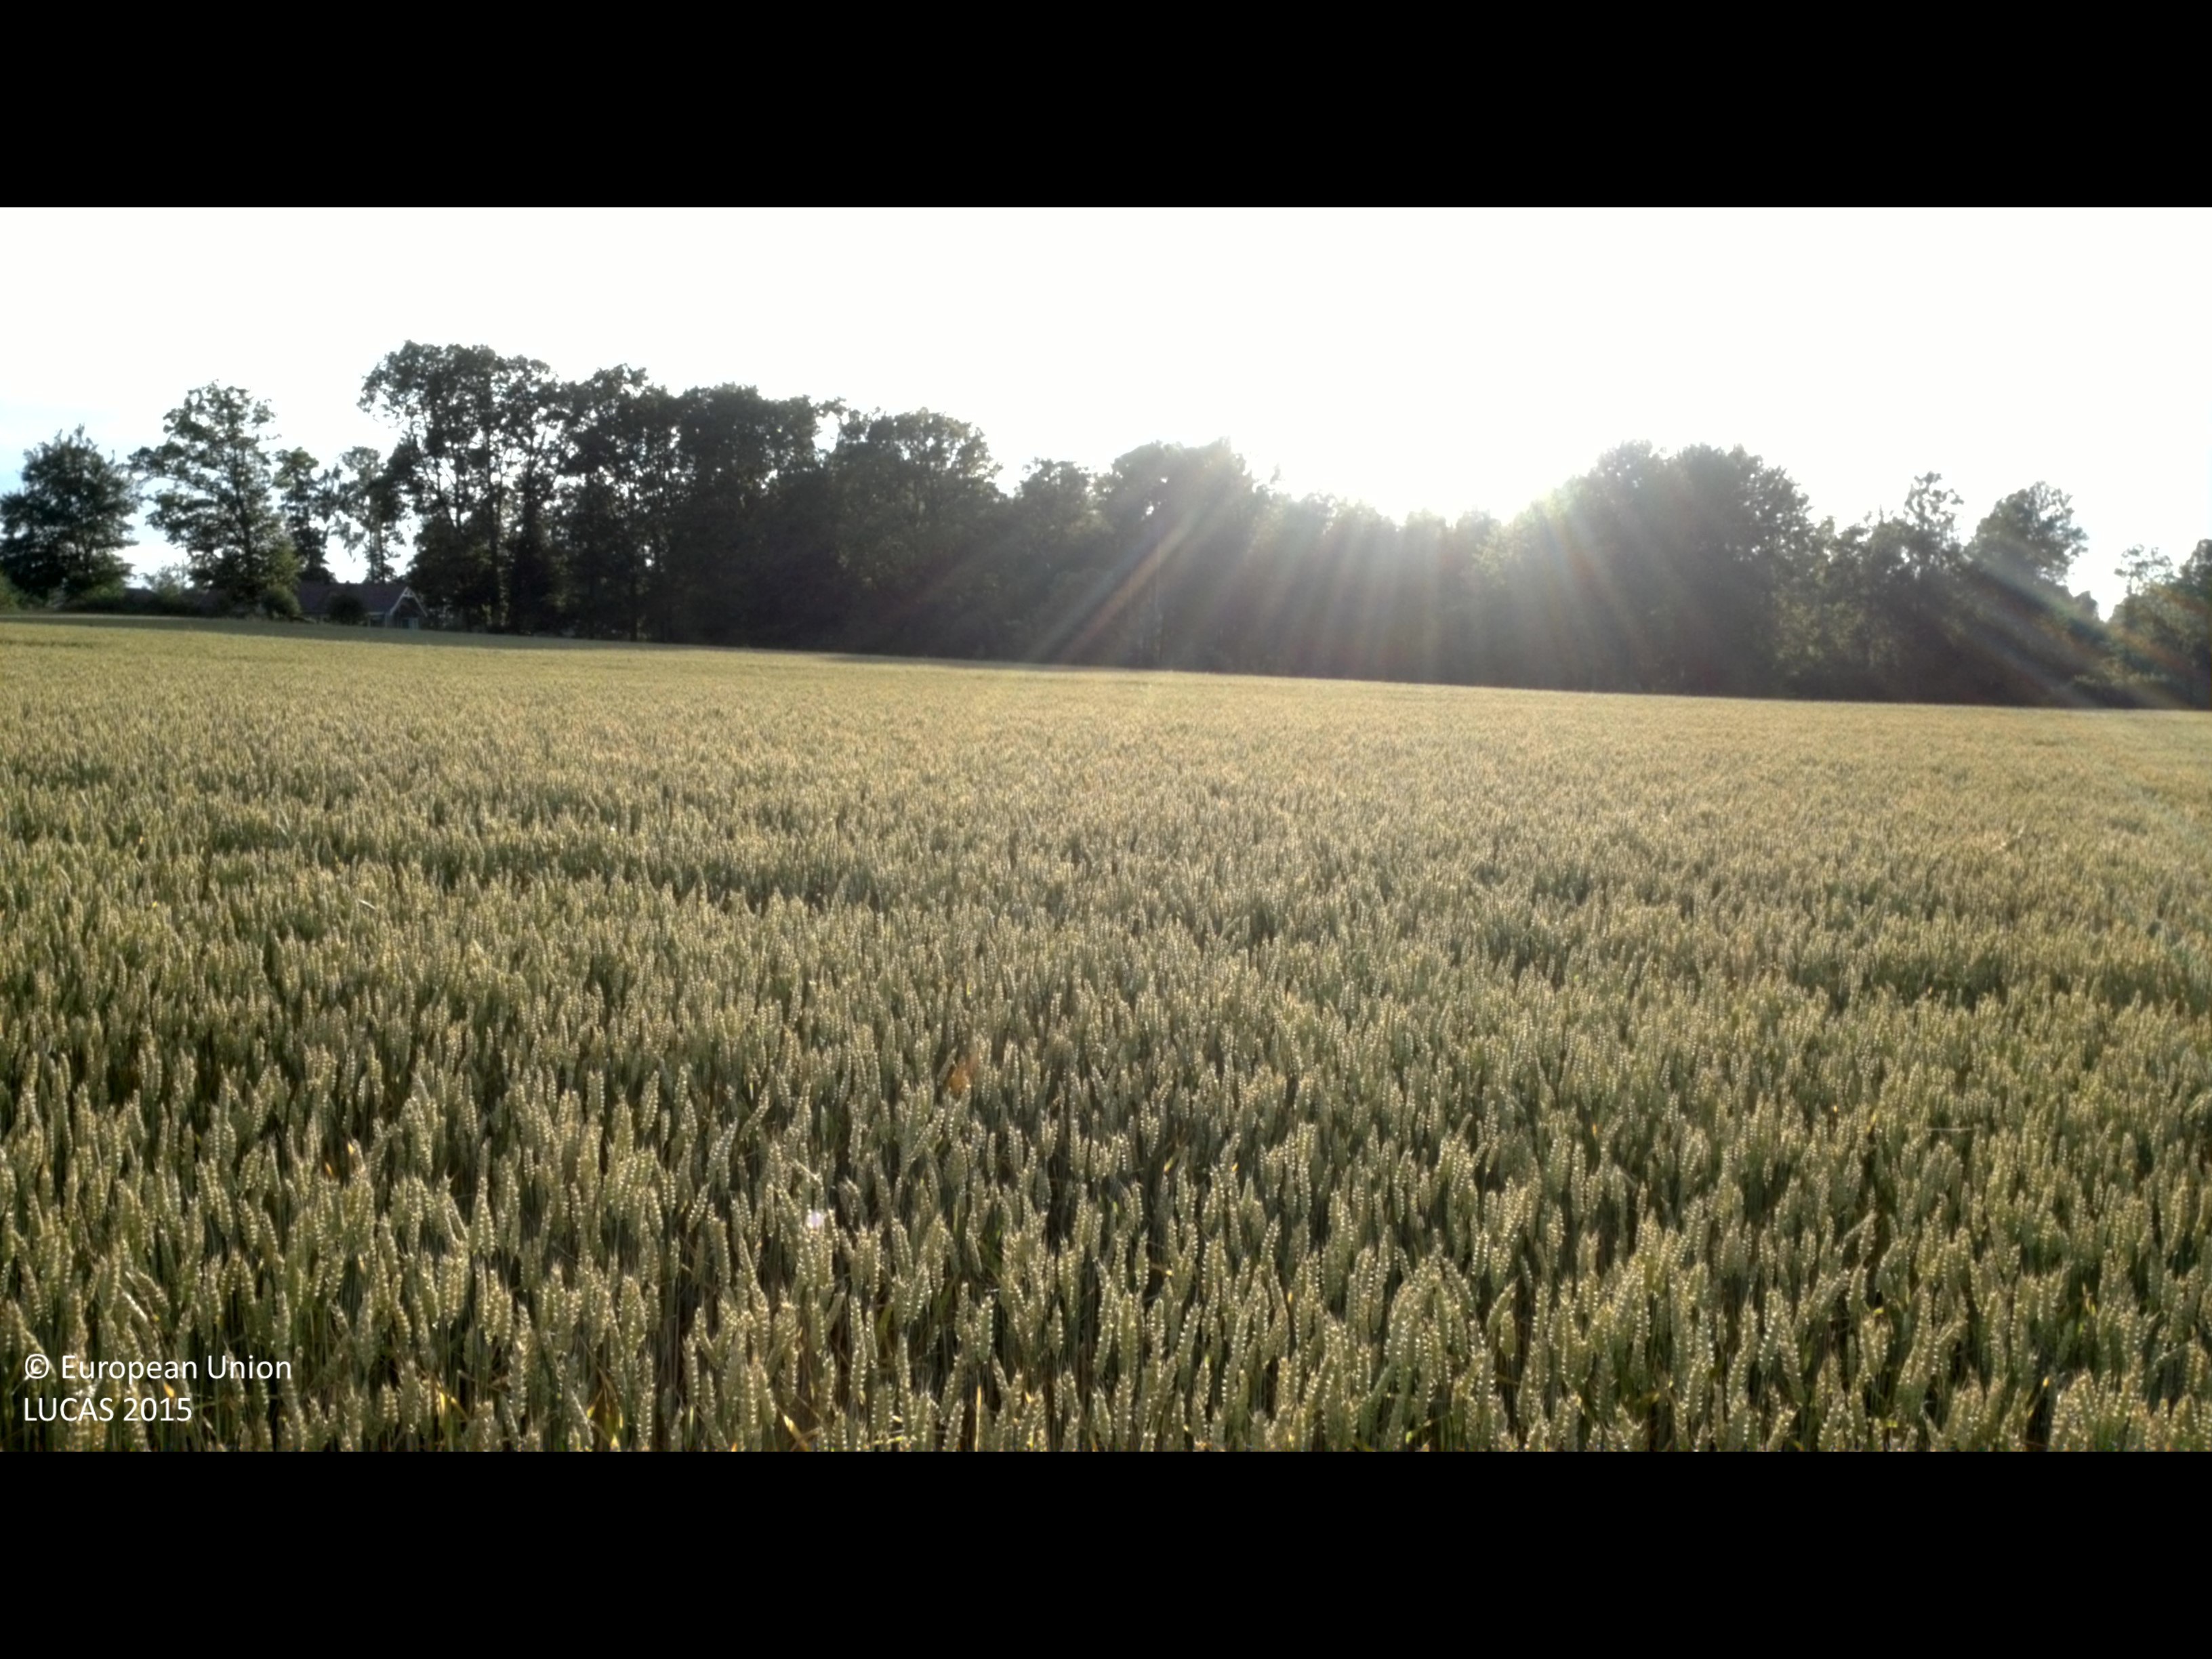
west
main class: Cropland
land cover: Common wheat
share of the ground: > 75 %
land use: Agriculture (excluding fallow land and kitchen gardens)
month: July
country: SE
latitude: 56.8142
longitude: 13.8461
